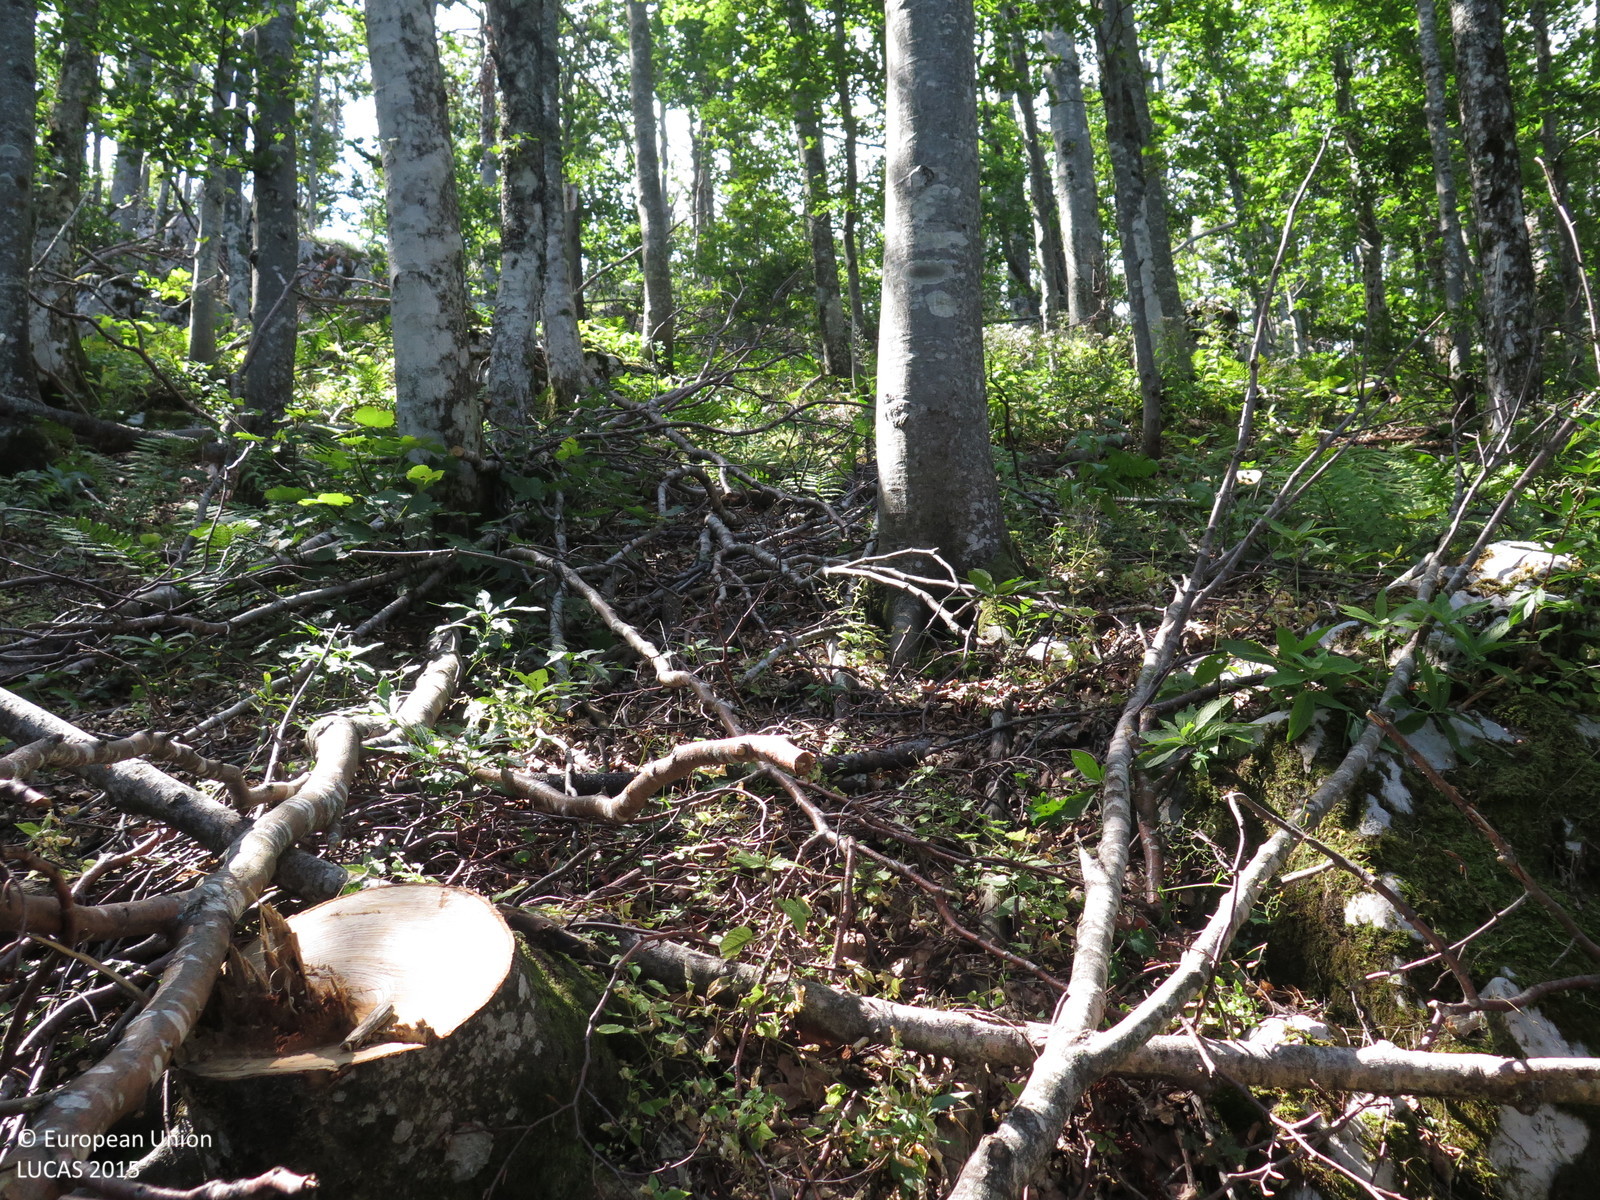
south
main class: Woodland
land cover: Broadleaved woodland
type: mountainous beech forest
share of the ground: > 75 %
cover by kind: broadleaved forest trees 75 %, coniferous forest trees 25 %
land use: Forestry
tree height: > 5 m
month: August
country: HR
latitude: 45.1707
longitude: 14.9698
